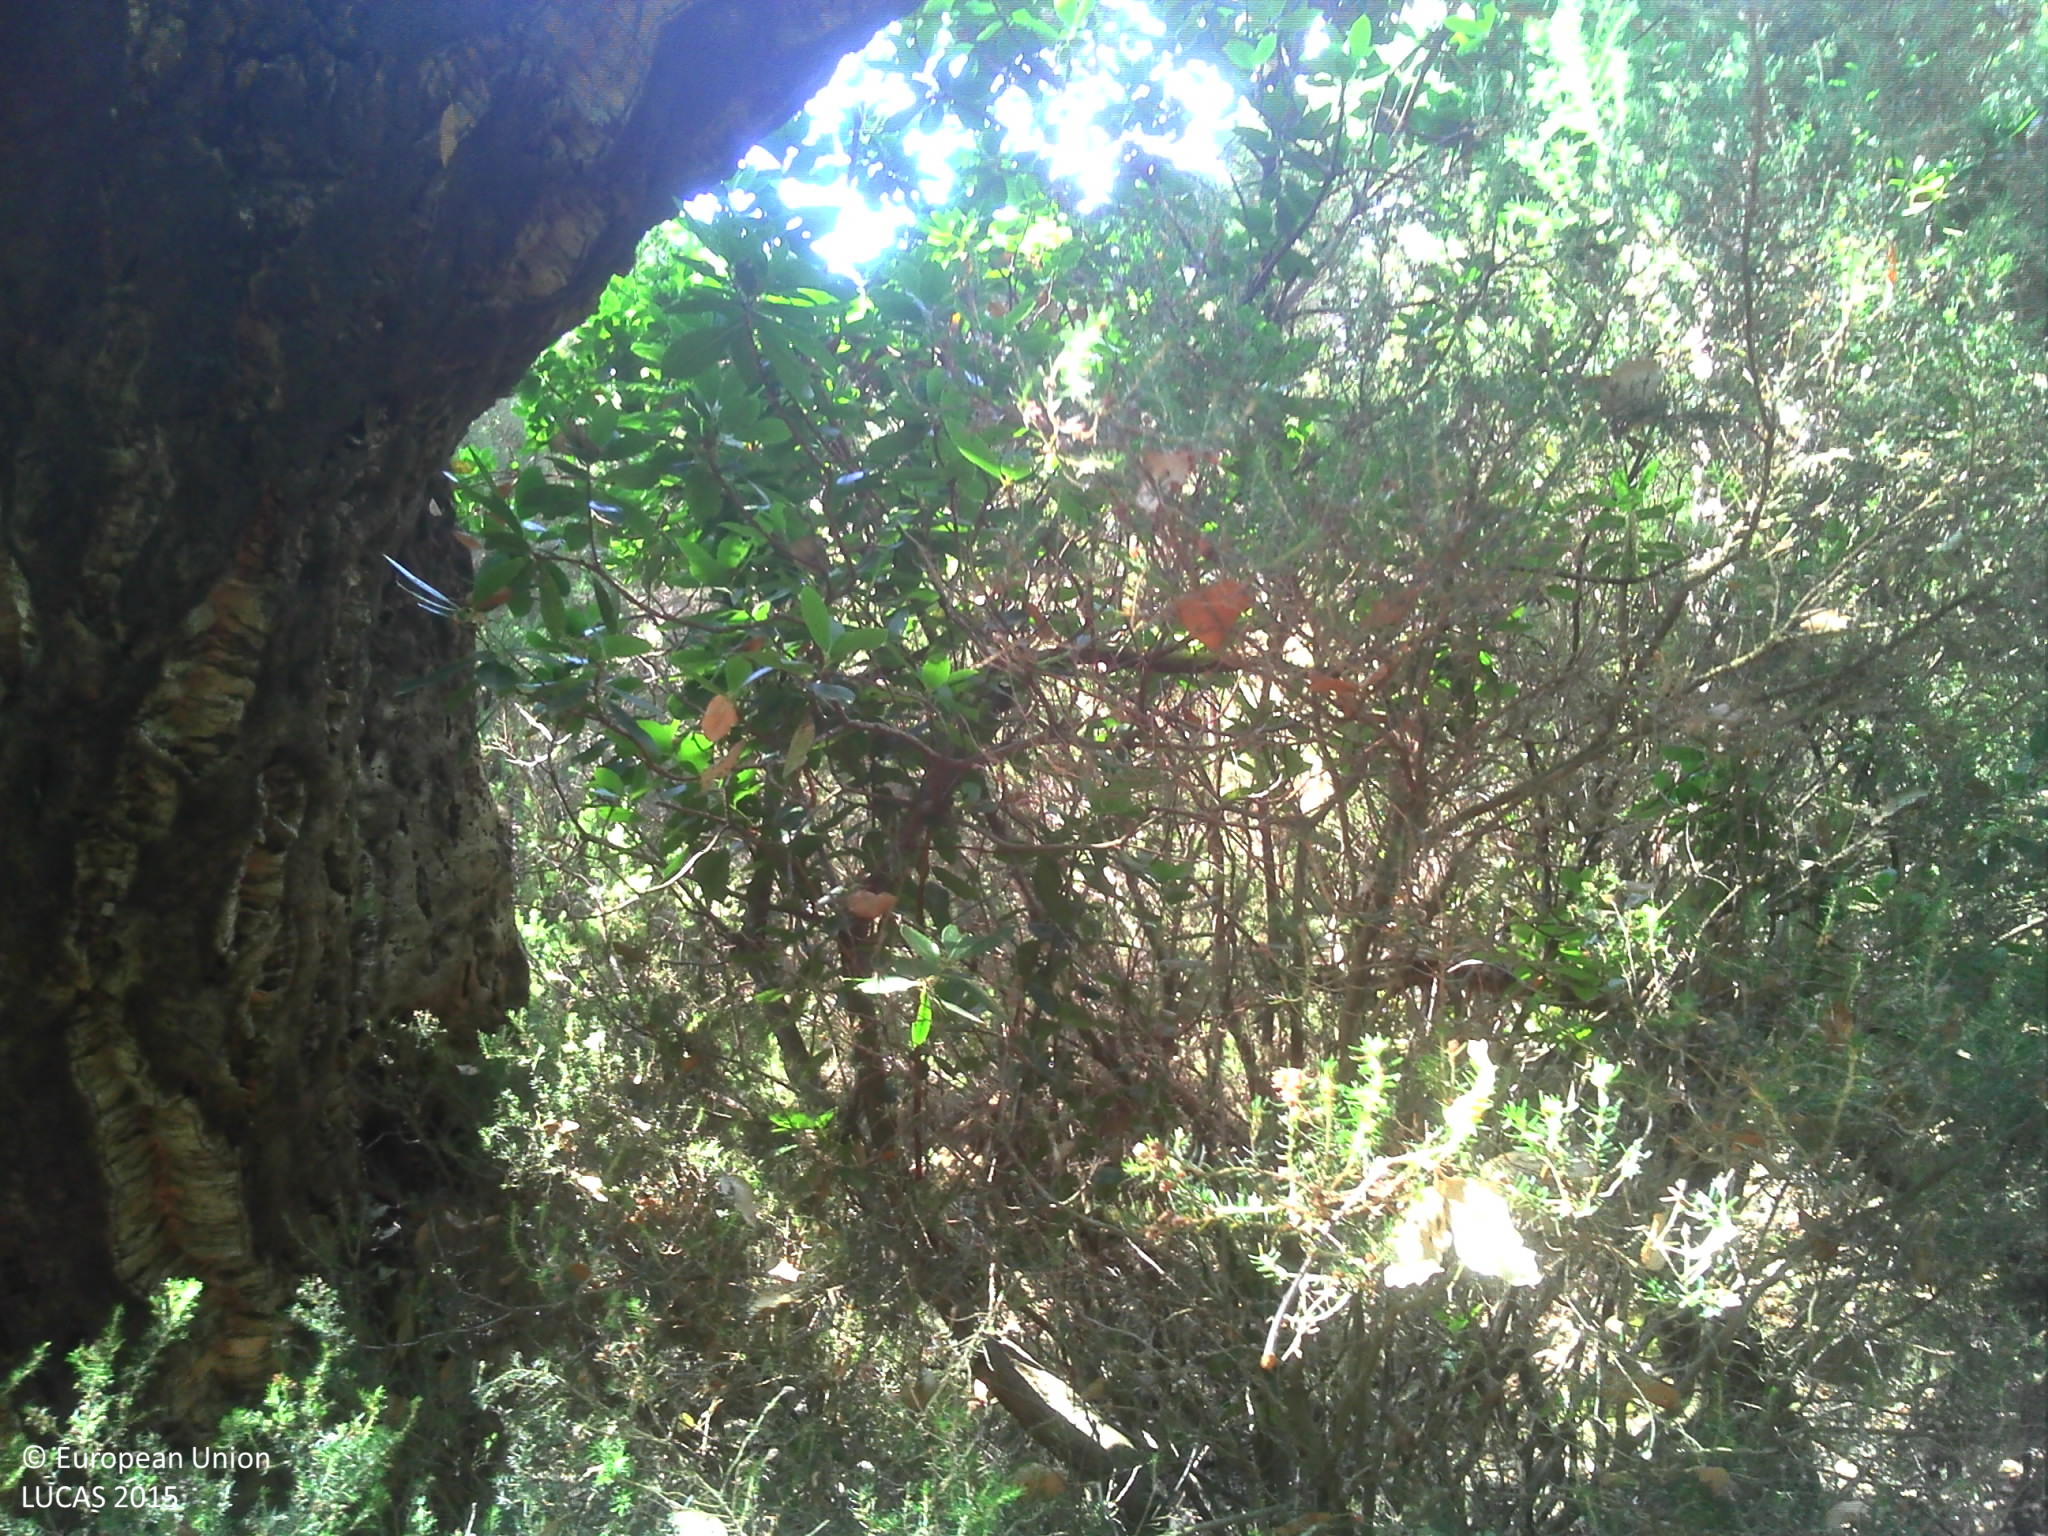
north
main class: Woodland
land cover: Broadleaved woodland
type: thermophilous deciduous forest
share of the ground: > 75 %
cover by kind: broadleaved forest trees 90 %, unconsolidated bare surface 10 %
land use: Semi-natural and natural areas not in use
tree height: > 5 m
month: July
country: FR
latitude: 43.1677
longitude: 6.3809
